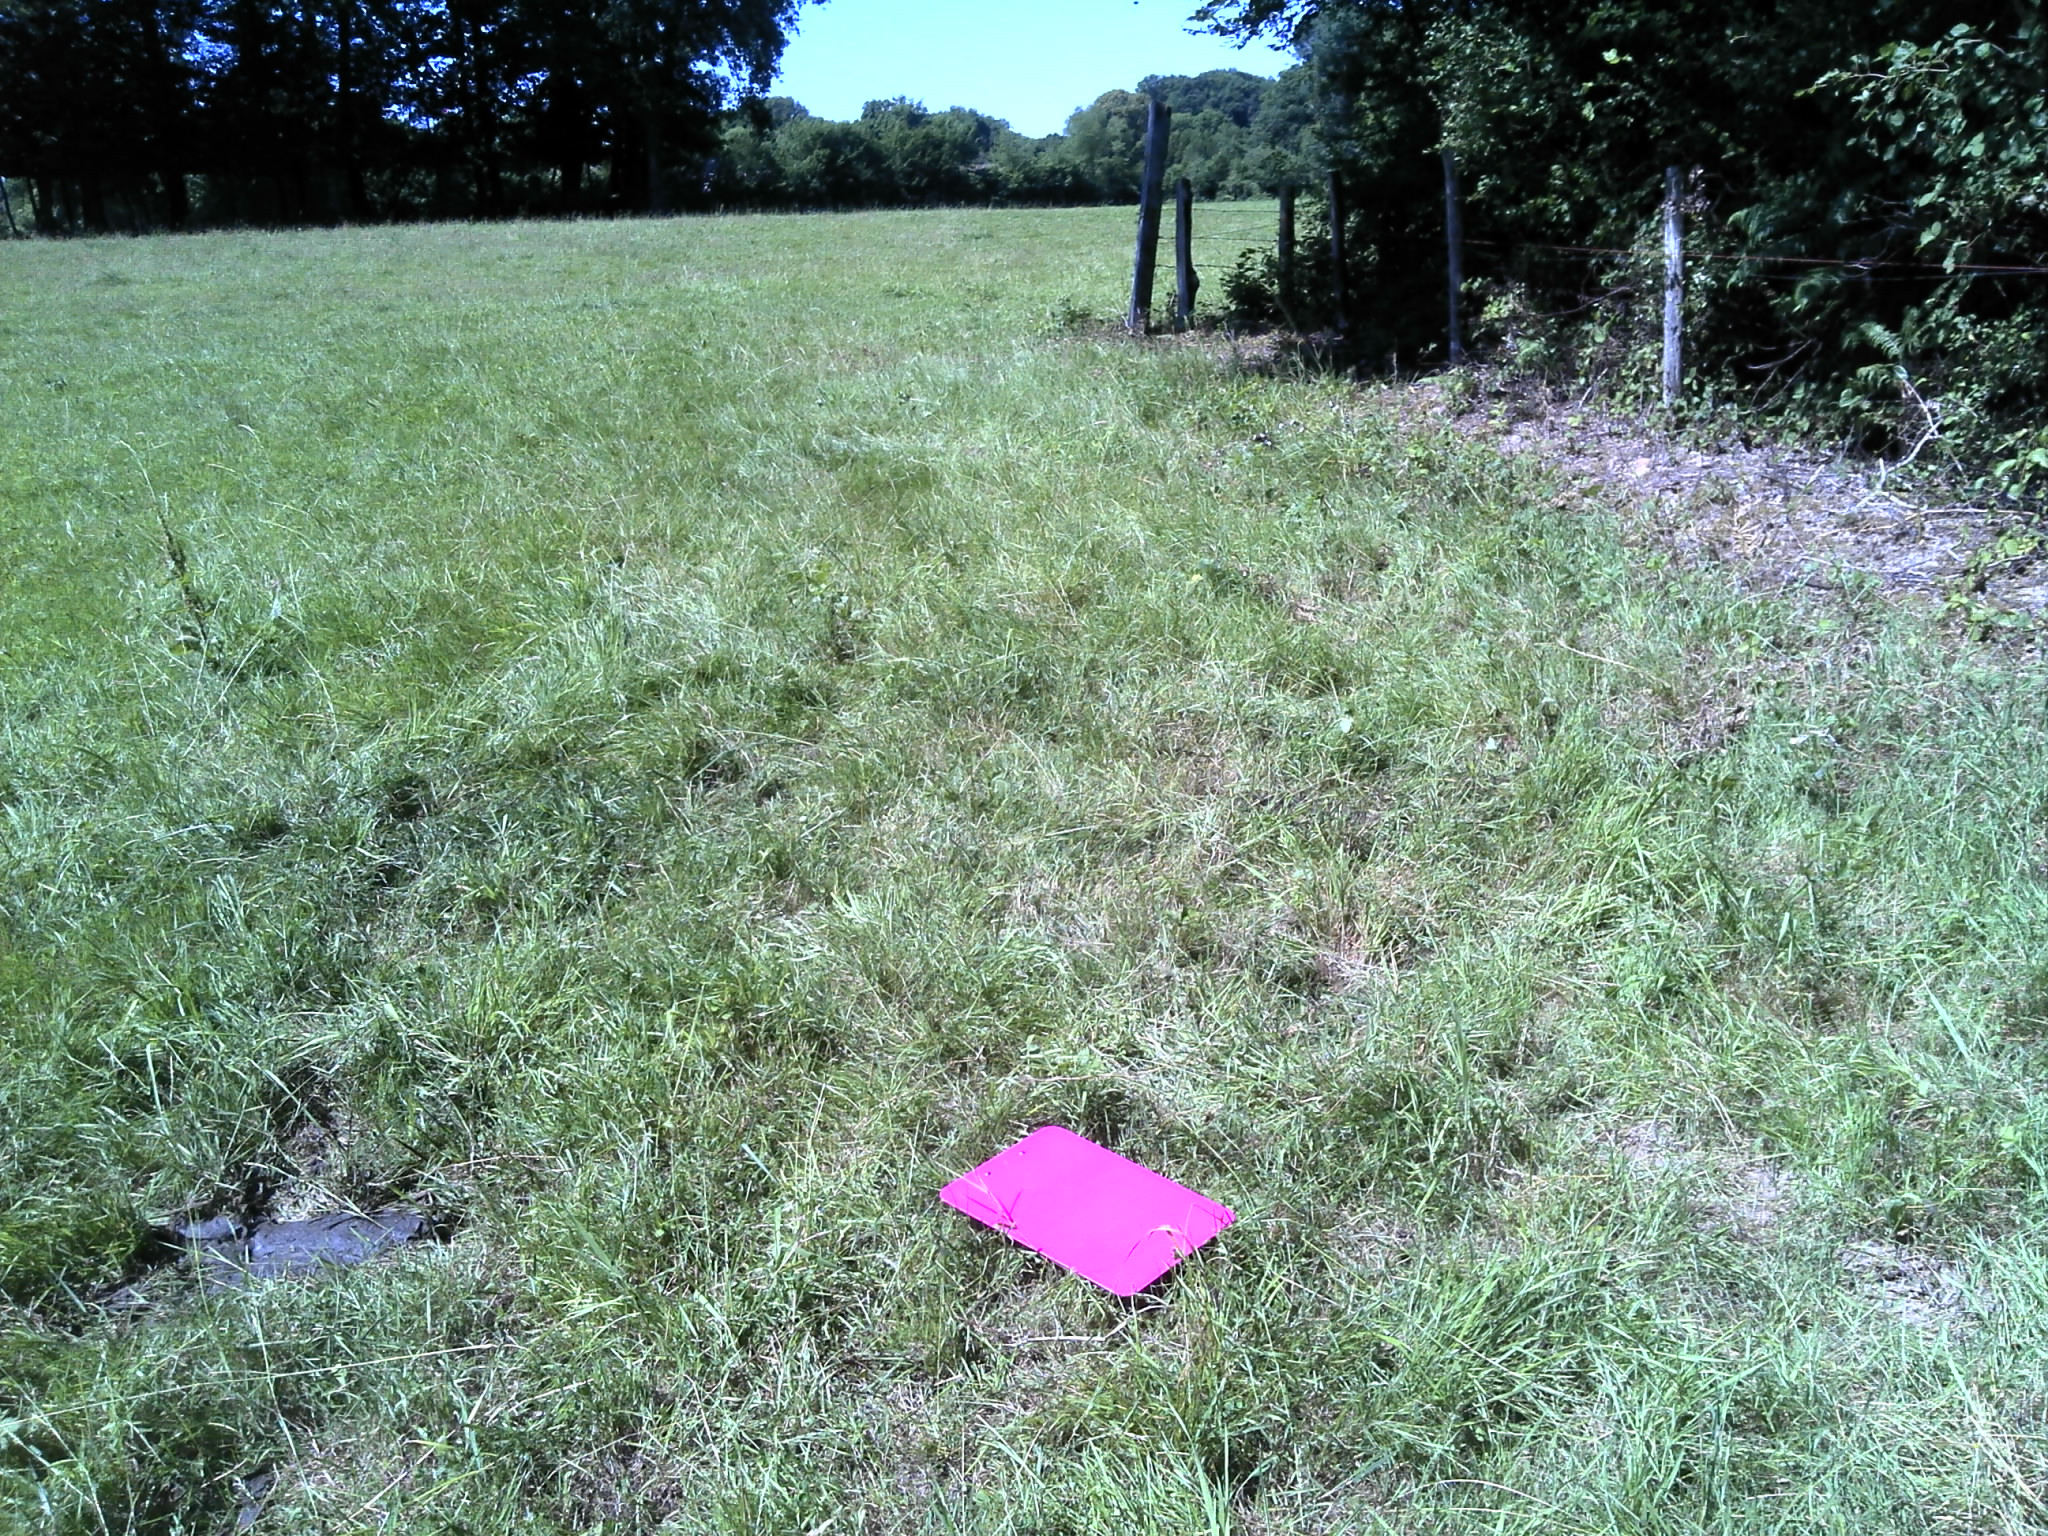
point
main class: Grassland
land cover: Grassland without tree/shrub cover
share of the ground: > 75 %
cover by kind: herbaceous plants 100 %
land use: Agriculture (excluding fallow land and kitchen gardens)
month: June
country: FR
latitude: 46.3966
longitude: 1.5497
